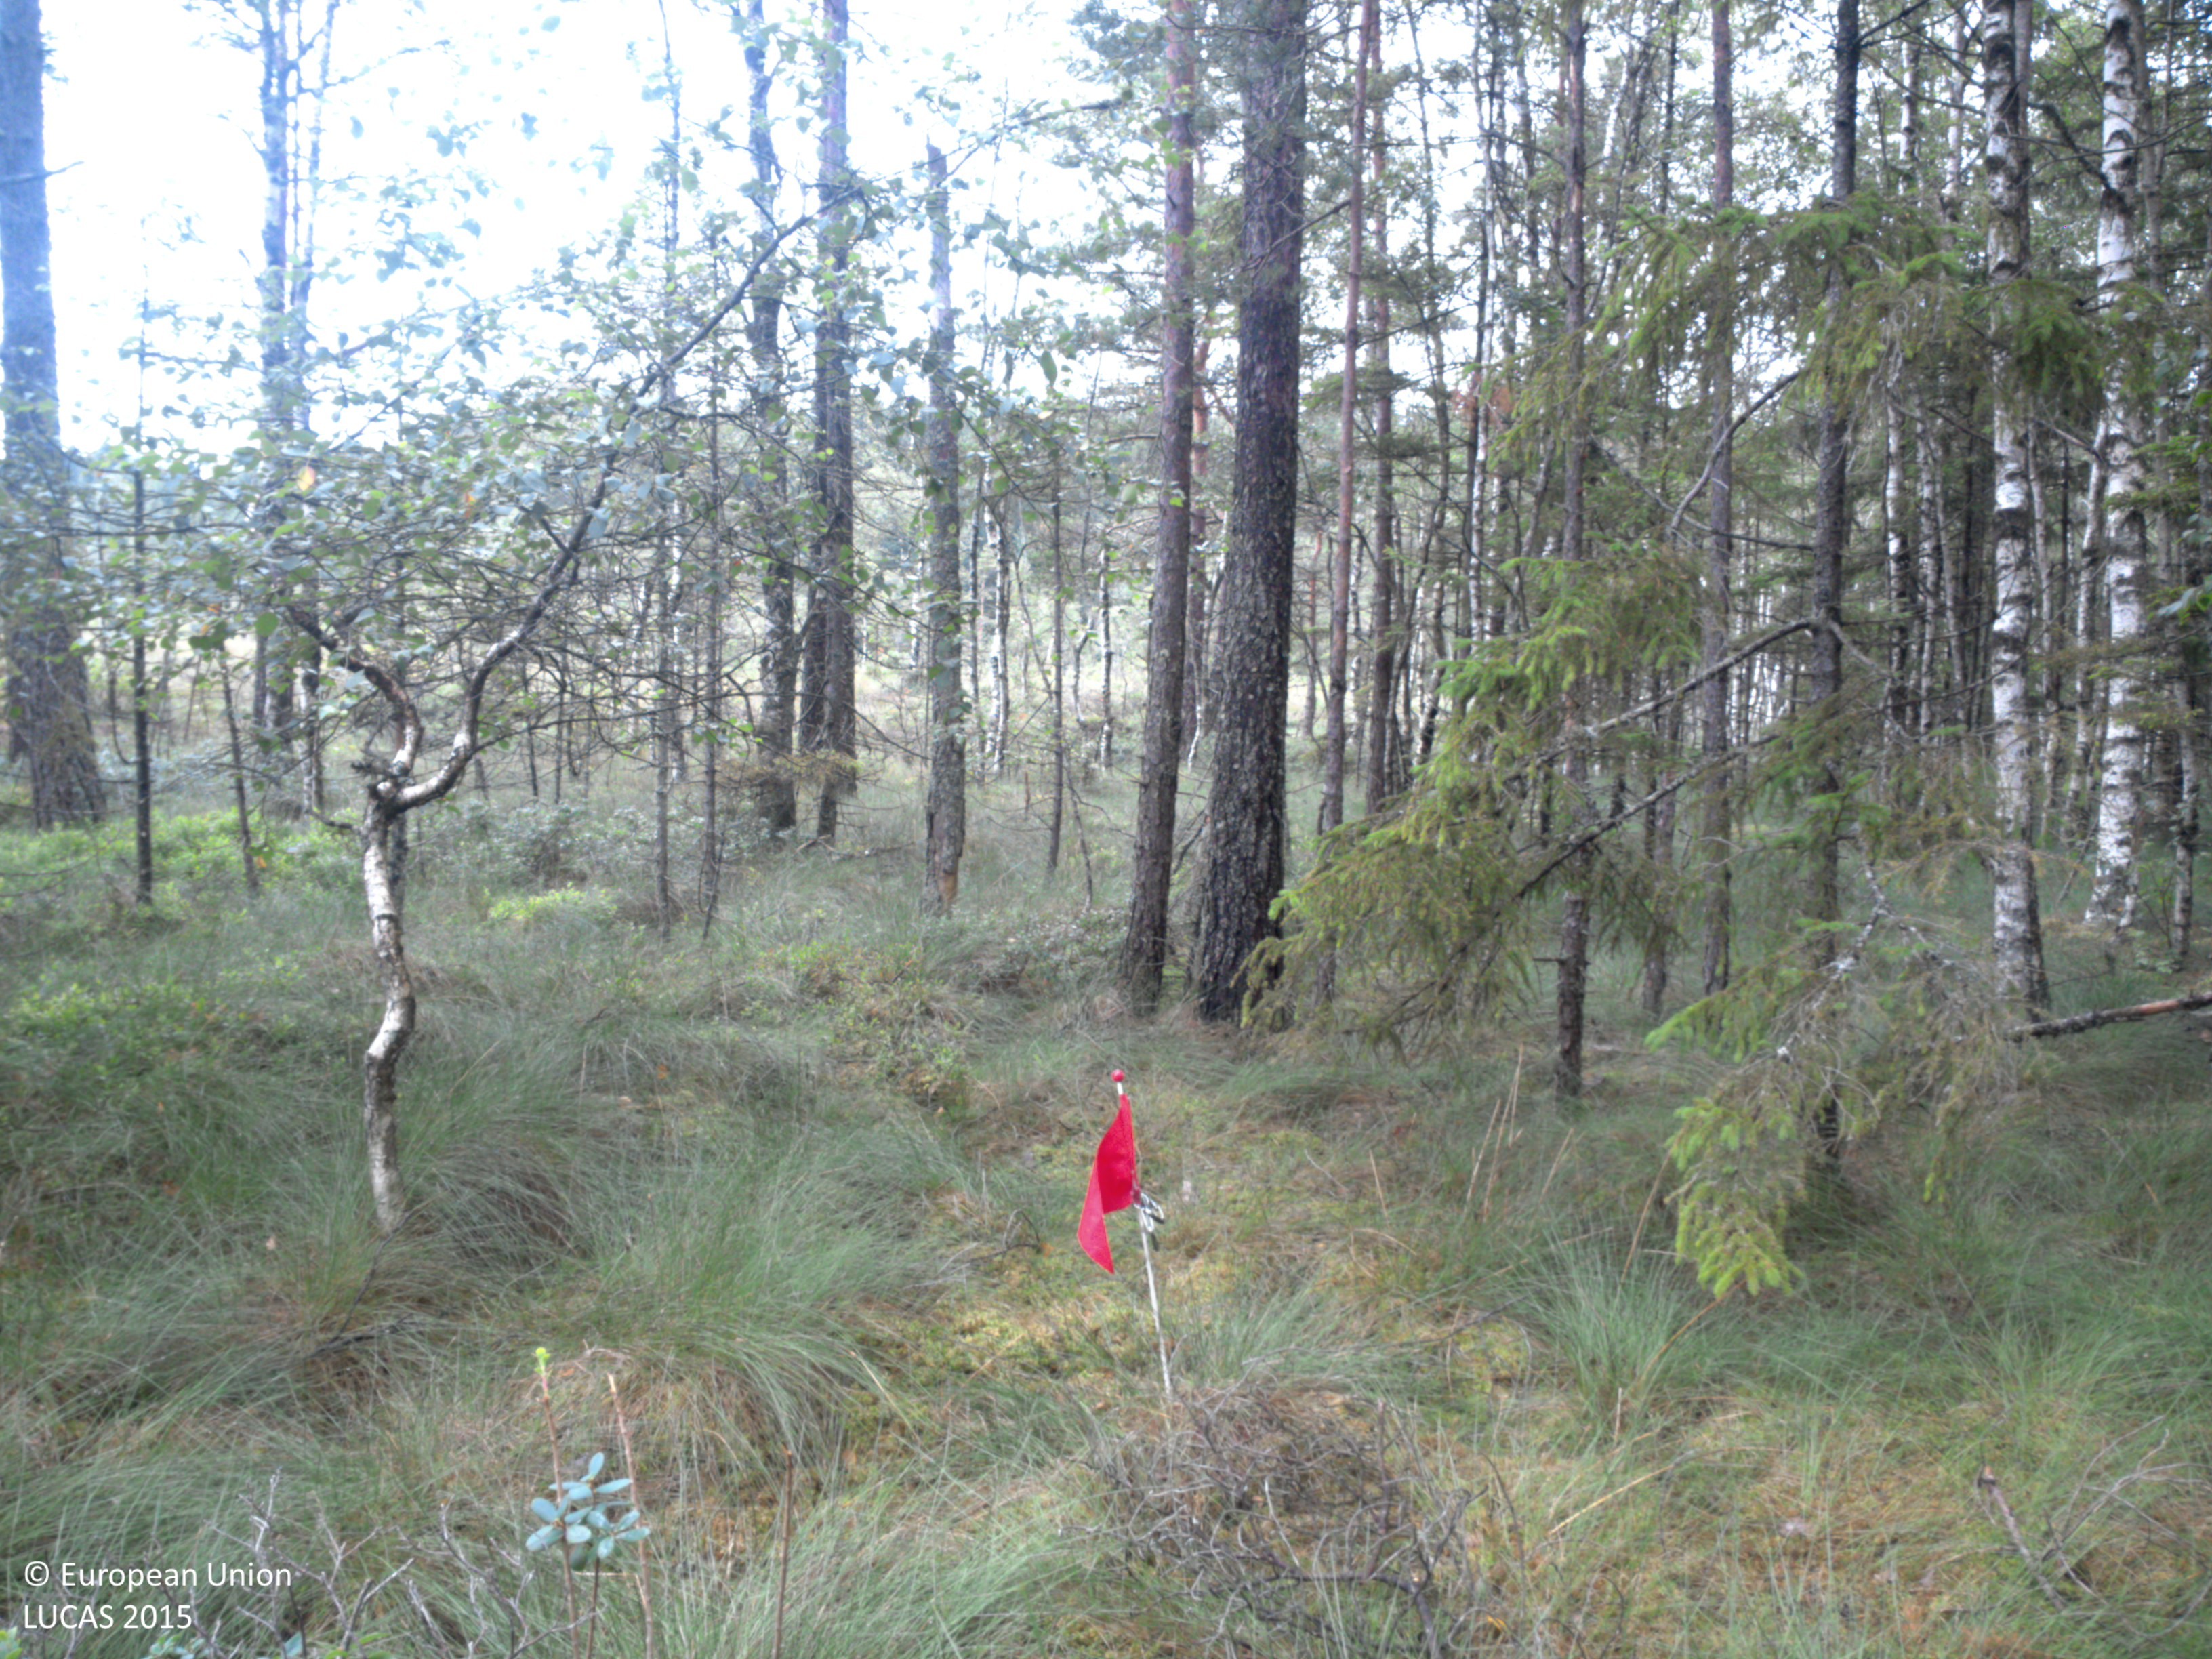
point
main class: Woodland
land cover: Pine dominated mixed woodland
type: boreal forest
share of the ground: 50 - 75 %
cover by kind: lichens and mosses 50 %, coniferous forest trees 30 %, broadleaved forest trees 20 %
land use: Semi-natural and natural areas not in use
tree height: < 5 m
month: July
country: SE
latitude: 58.6183
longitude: 12.0101
